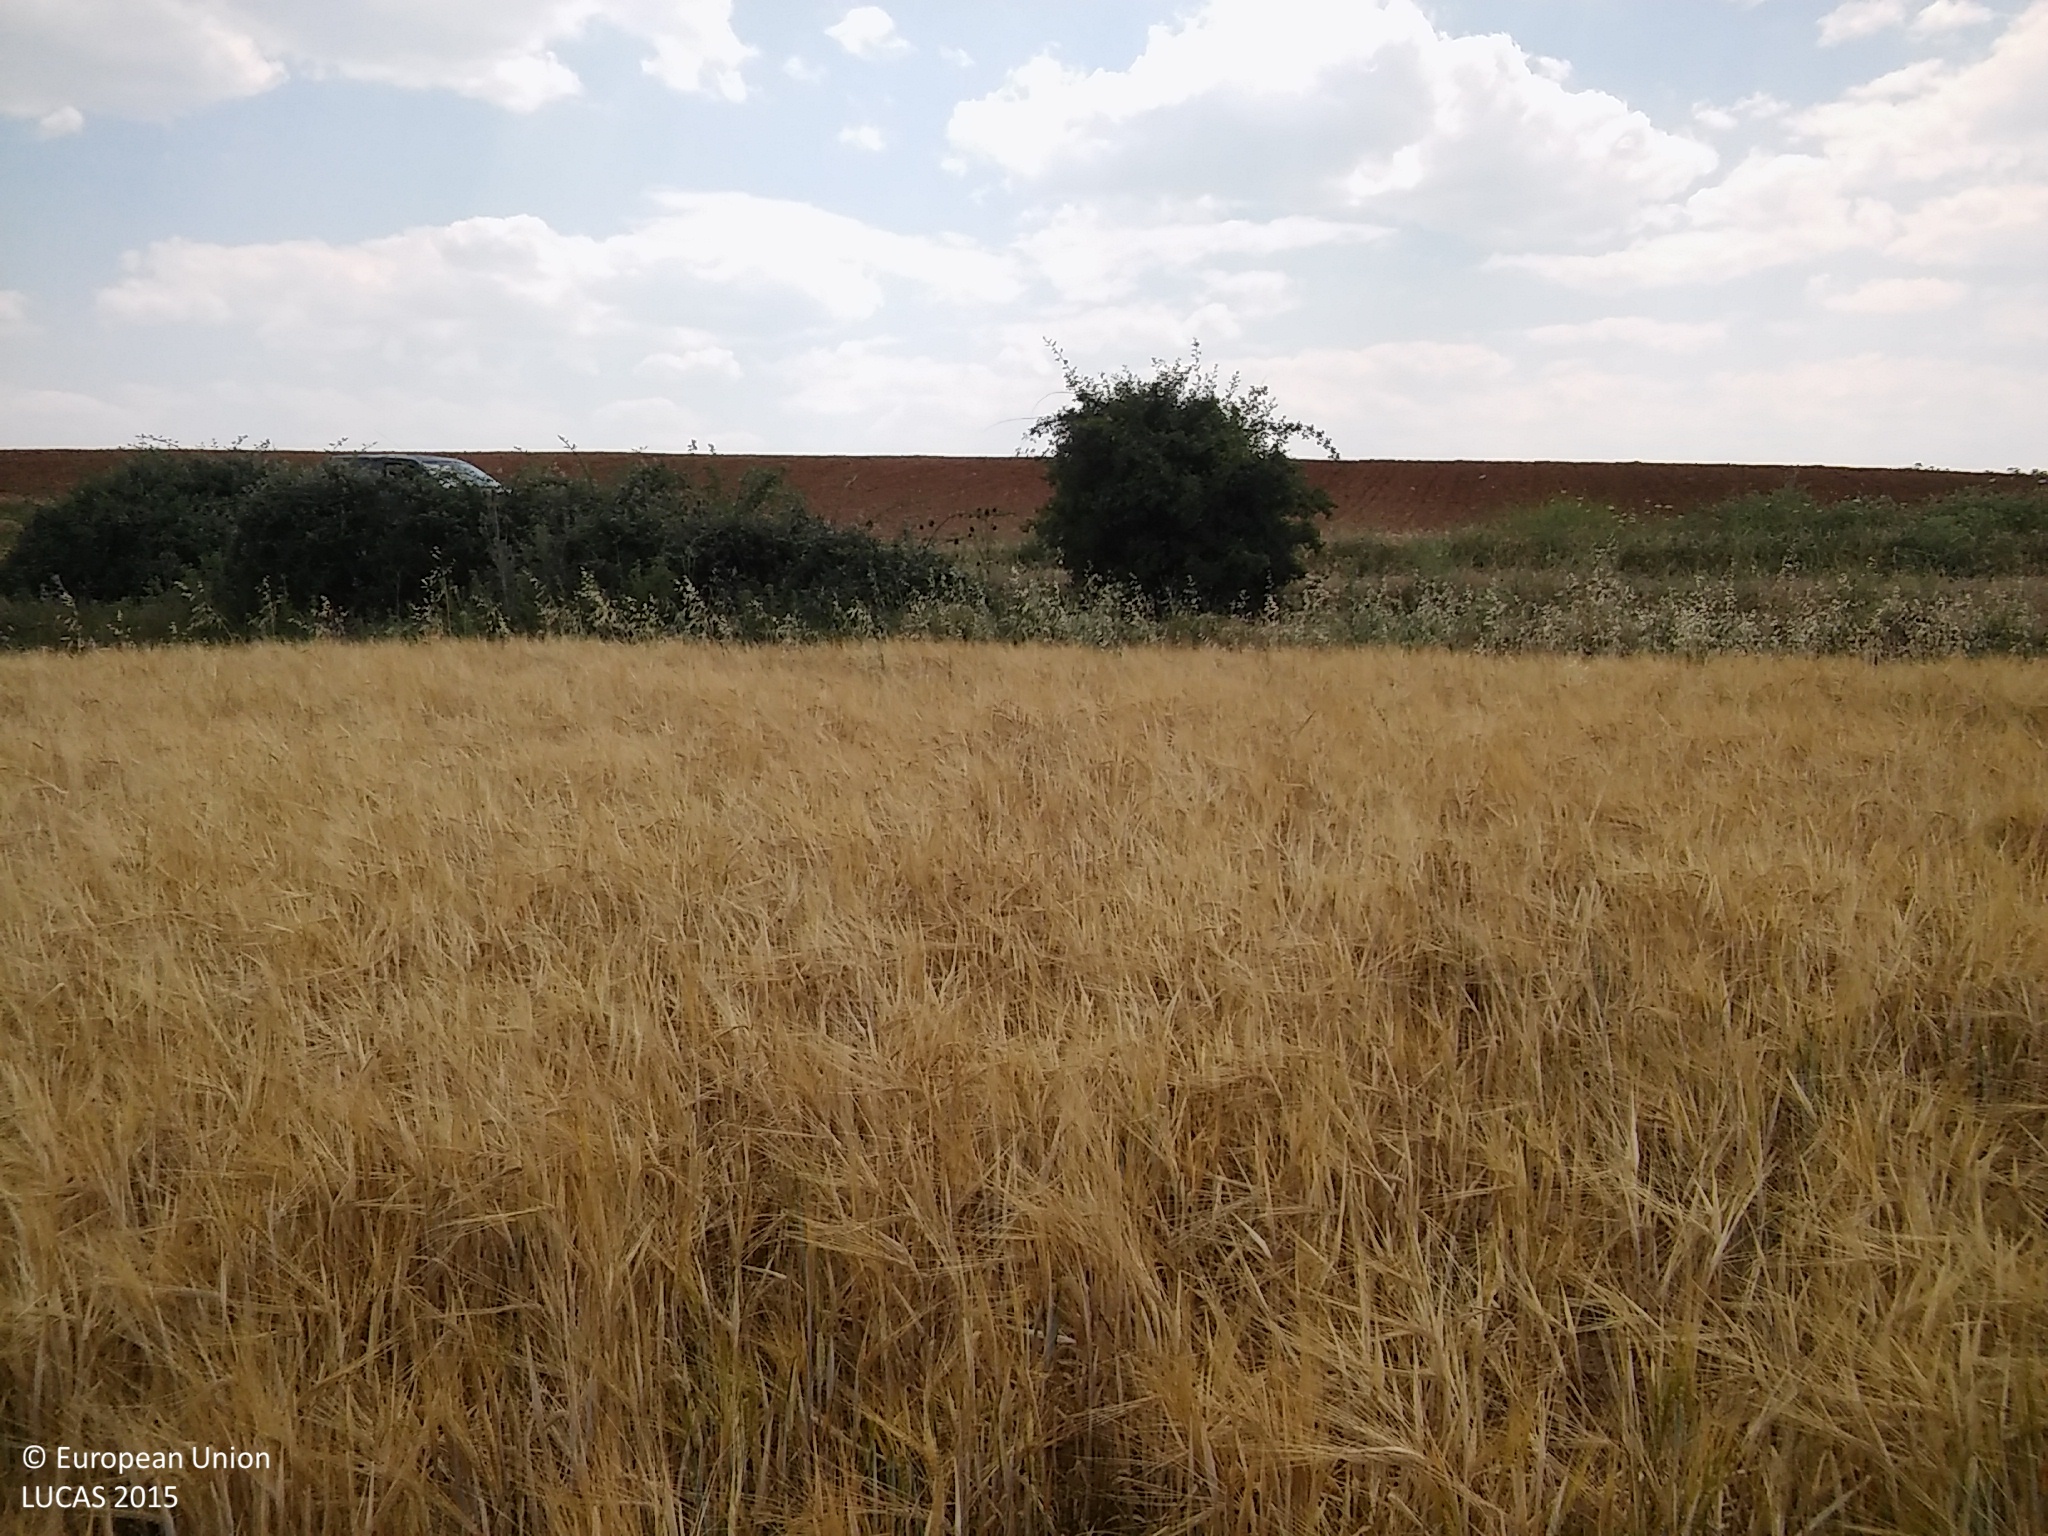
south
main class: Cropland
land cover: Barley
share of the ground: > 75 %
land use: Agriculture (excluding fallow land and kitchen gardens)
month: June
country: ES
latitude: 41.3913
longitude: -3.5498
